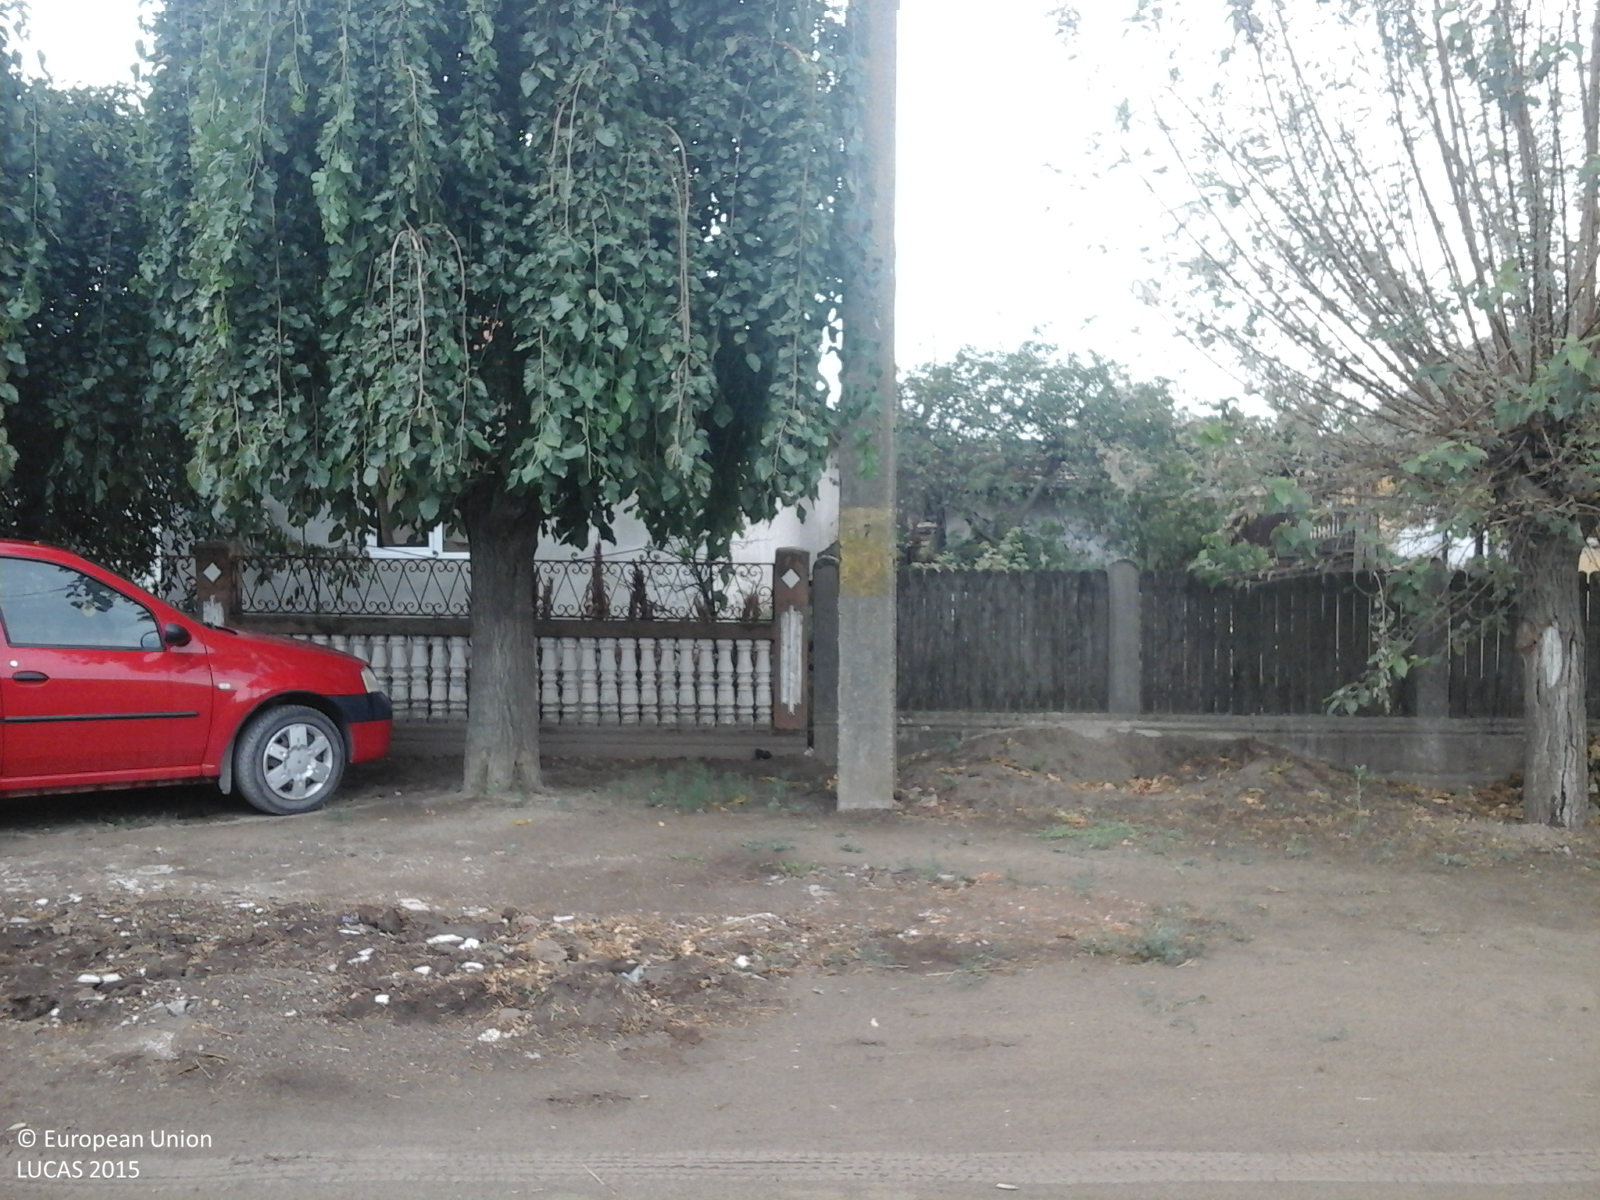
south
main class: Cropland
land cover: Other leguminous and mixtures for fodder
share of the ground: > 75 %
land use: Kitchen garden
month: August
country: RO
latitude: 43.9263
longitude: 23.0324
